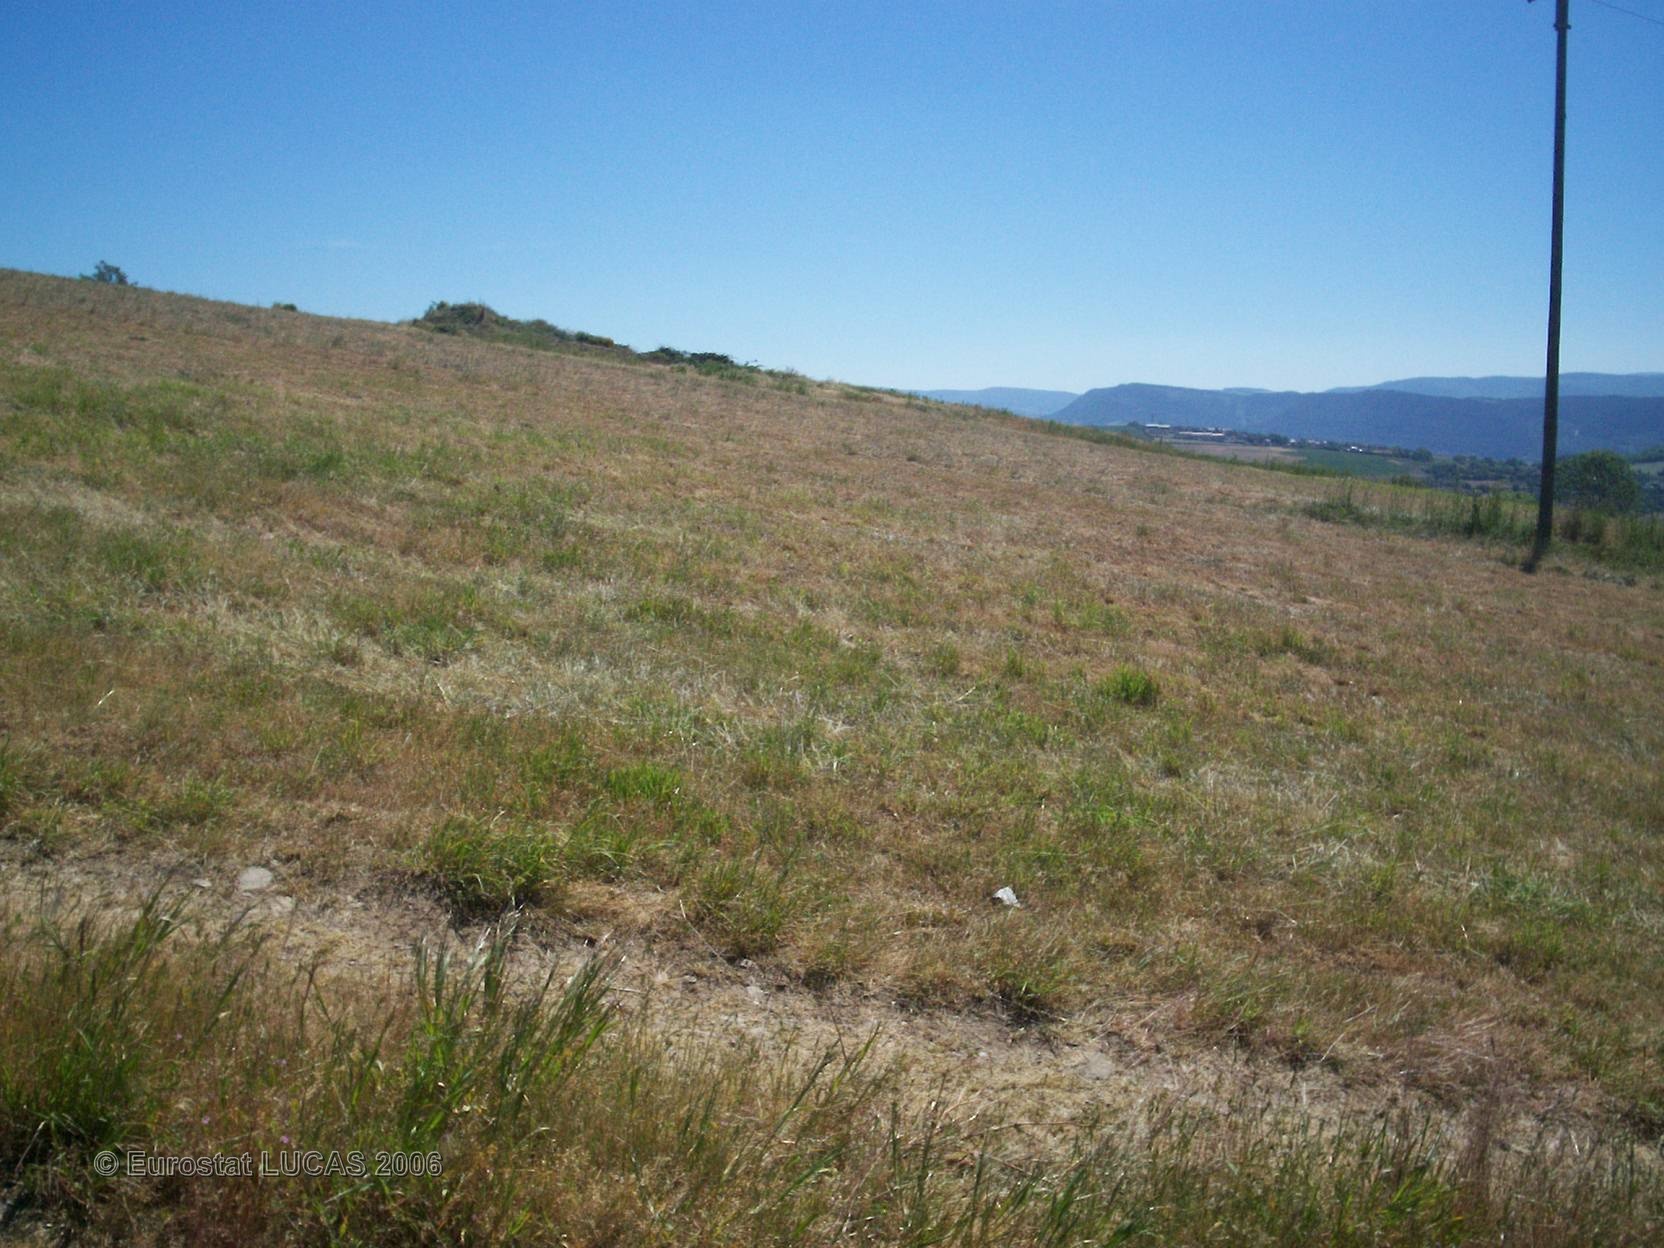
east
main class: Grassland
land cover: Grassland without tree/shrub cover
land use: Agriculture (excluding fallow land and kitchen gardens)
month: June
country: FR
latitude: 44.5398
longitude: 3.4227
